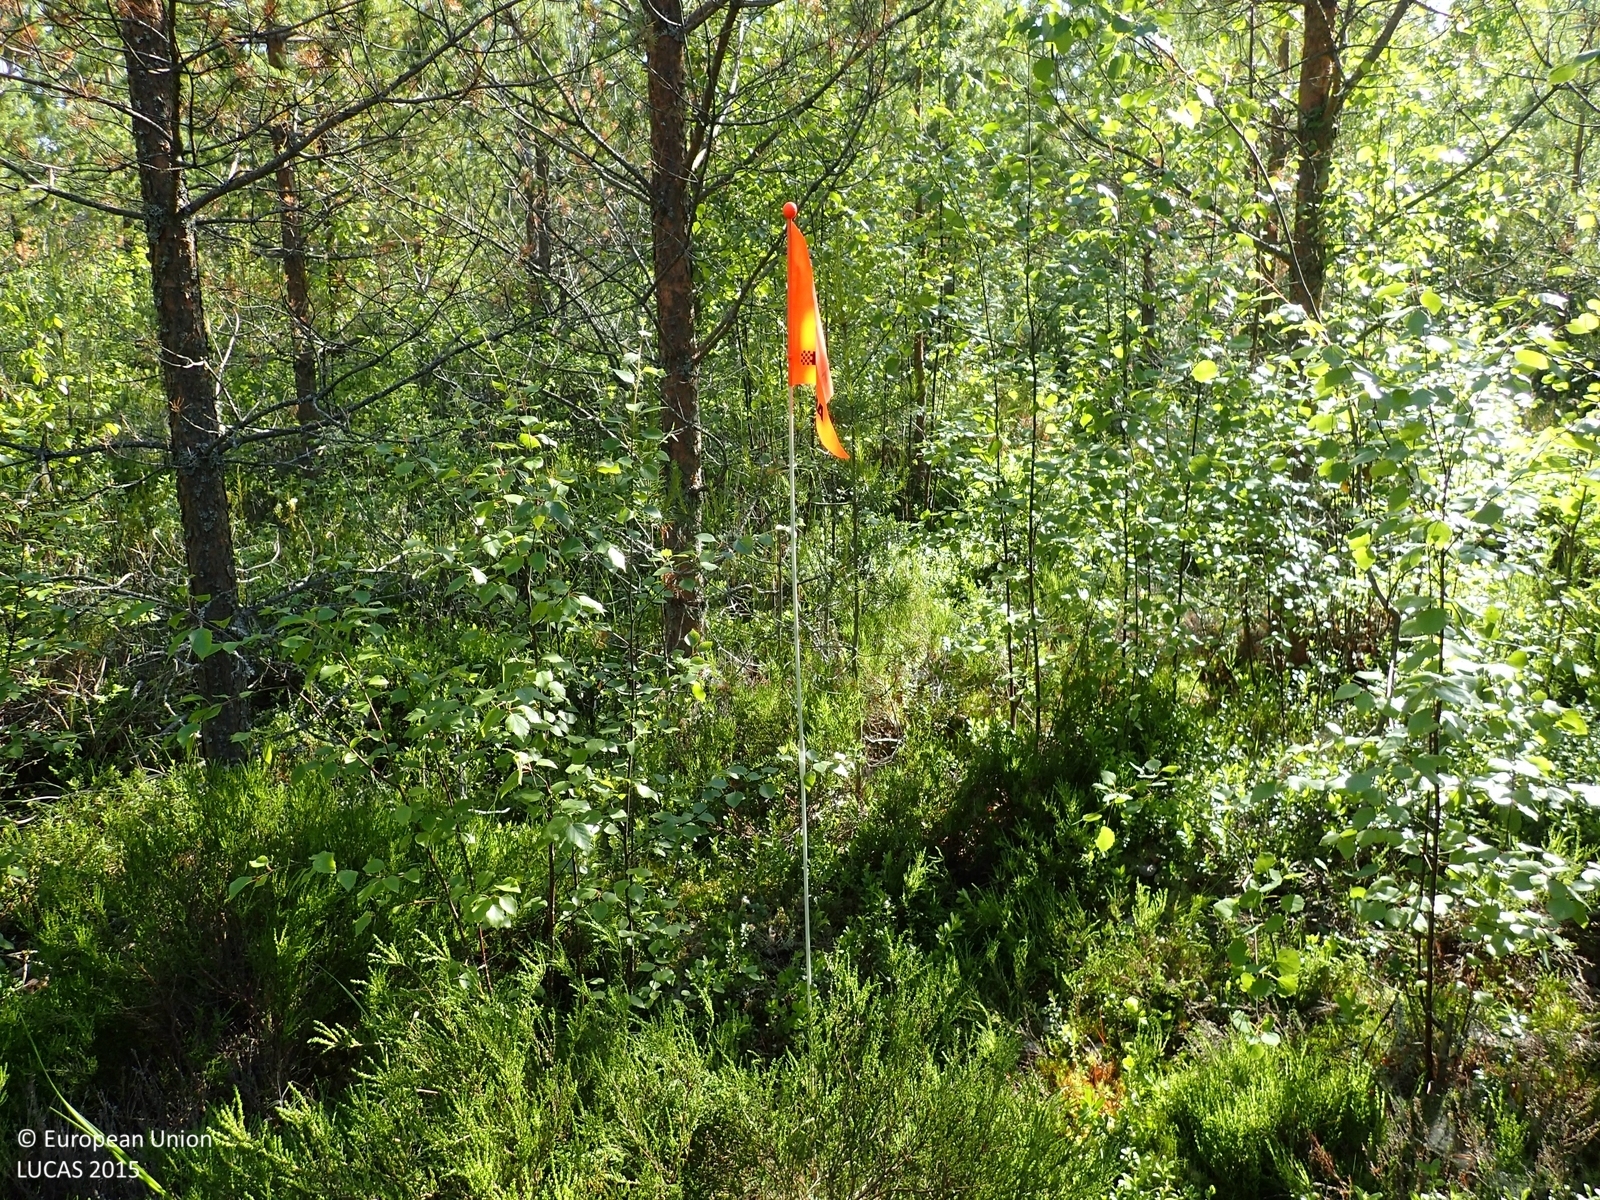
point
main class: Woodland
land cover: Pine dominated mixed woodland
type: boreal forest
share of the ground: 50 - 75 %
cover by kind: coniferous forest trees 50 %, broadleaved forest trees 20 %, shrubs 20 %, herbaceous plants 5 %, lichens and mosses 5 %
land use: Forestry
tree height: < 5 m
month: July
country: FI
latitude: 62.6188
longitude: 21.3647
